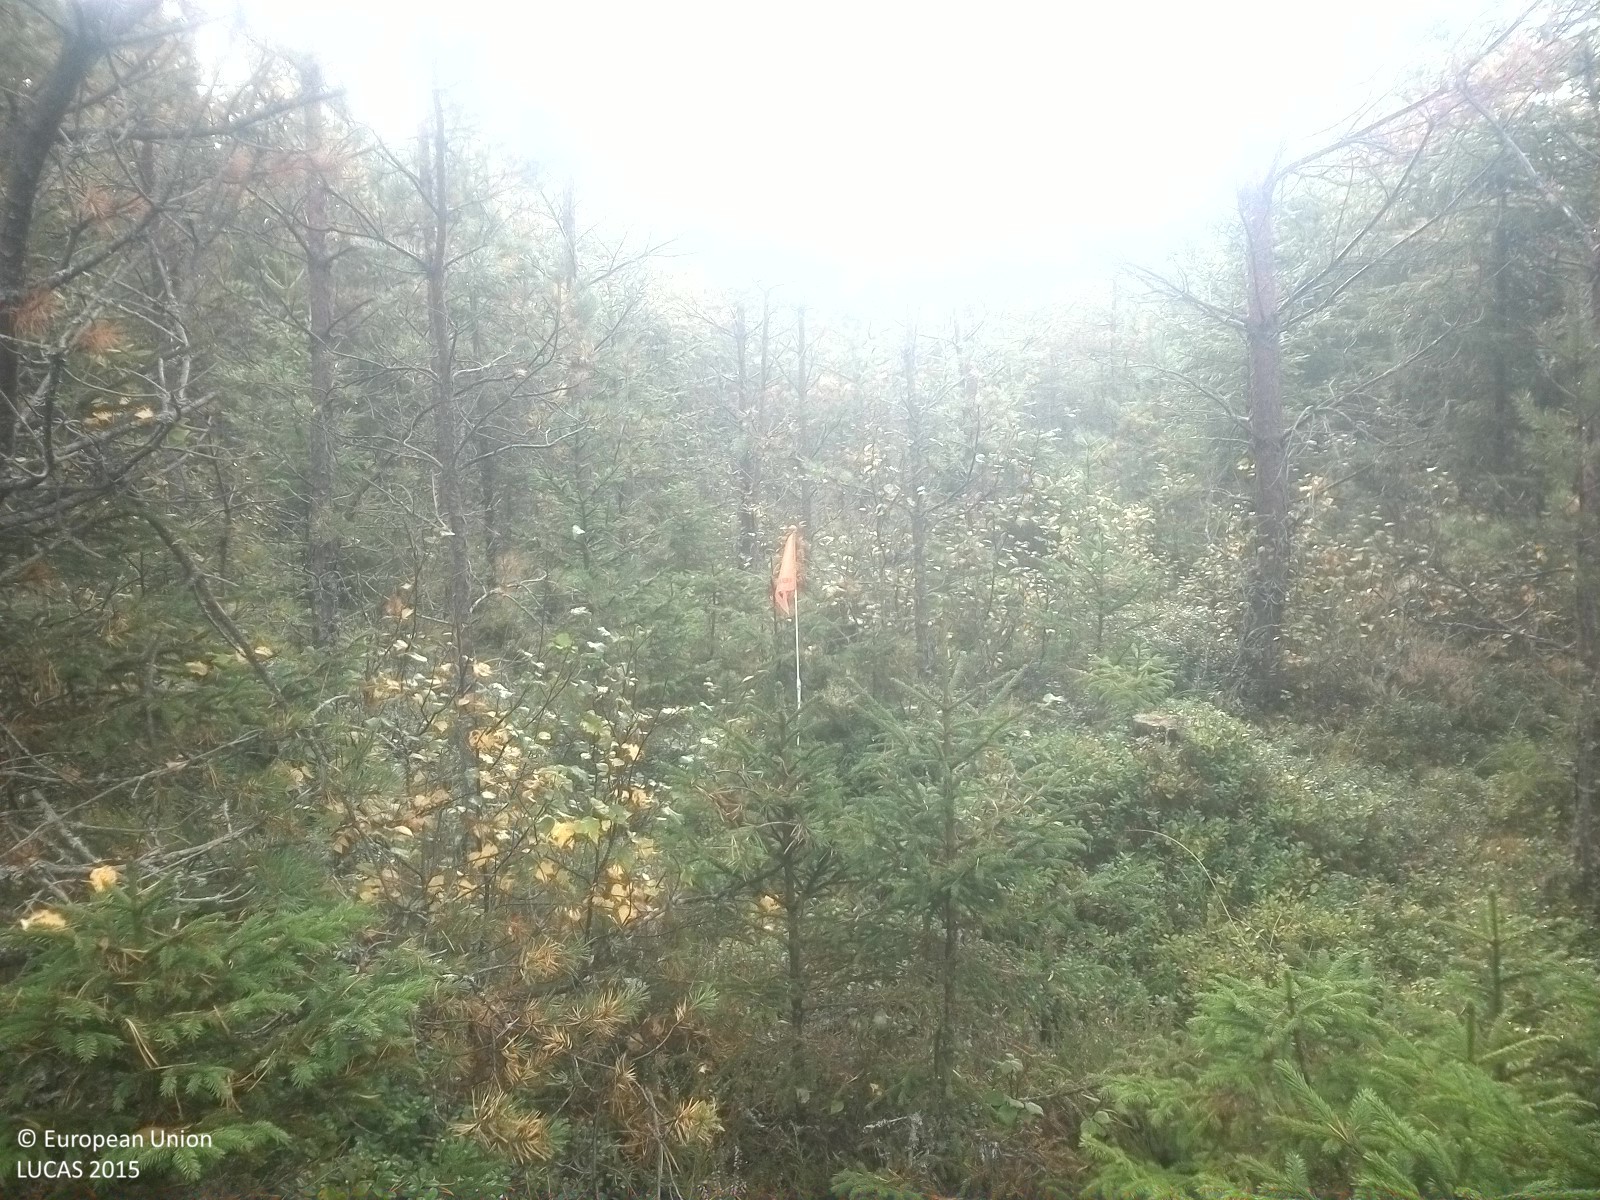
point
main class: Woodland
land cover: Pine dominated coniferous woodland
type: boreal forest
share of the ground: 25 - 50 %
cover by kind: coniferous forest trees 35 %, herbaceous plants 35 %, lichens and mosses 15 %, shrubs 10 %, broadleaved forest trees 5 %
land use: Forestry
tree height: < 5 m
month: September
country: SE
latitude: 58.8593
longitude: 15.6277
